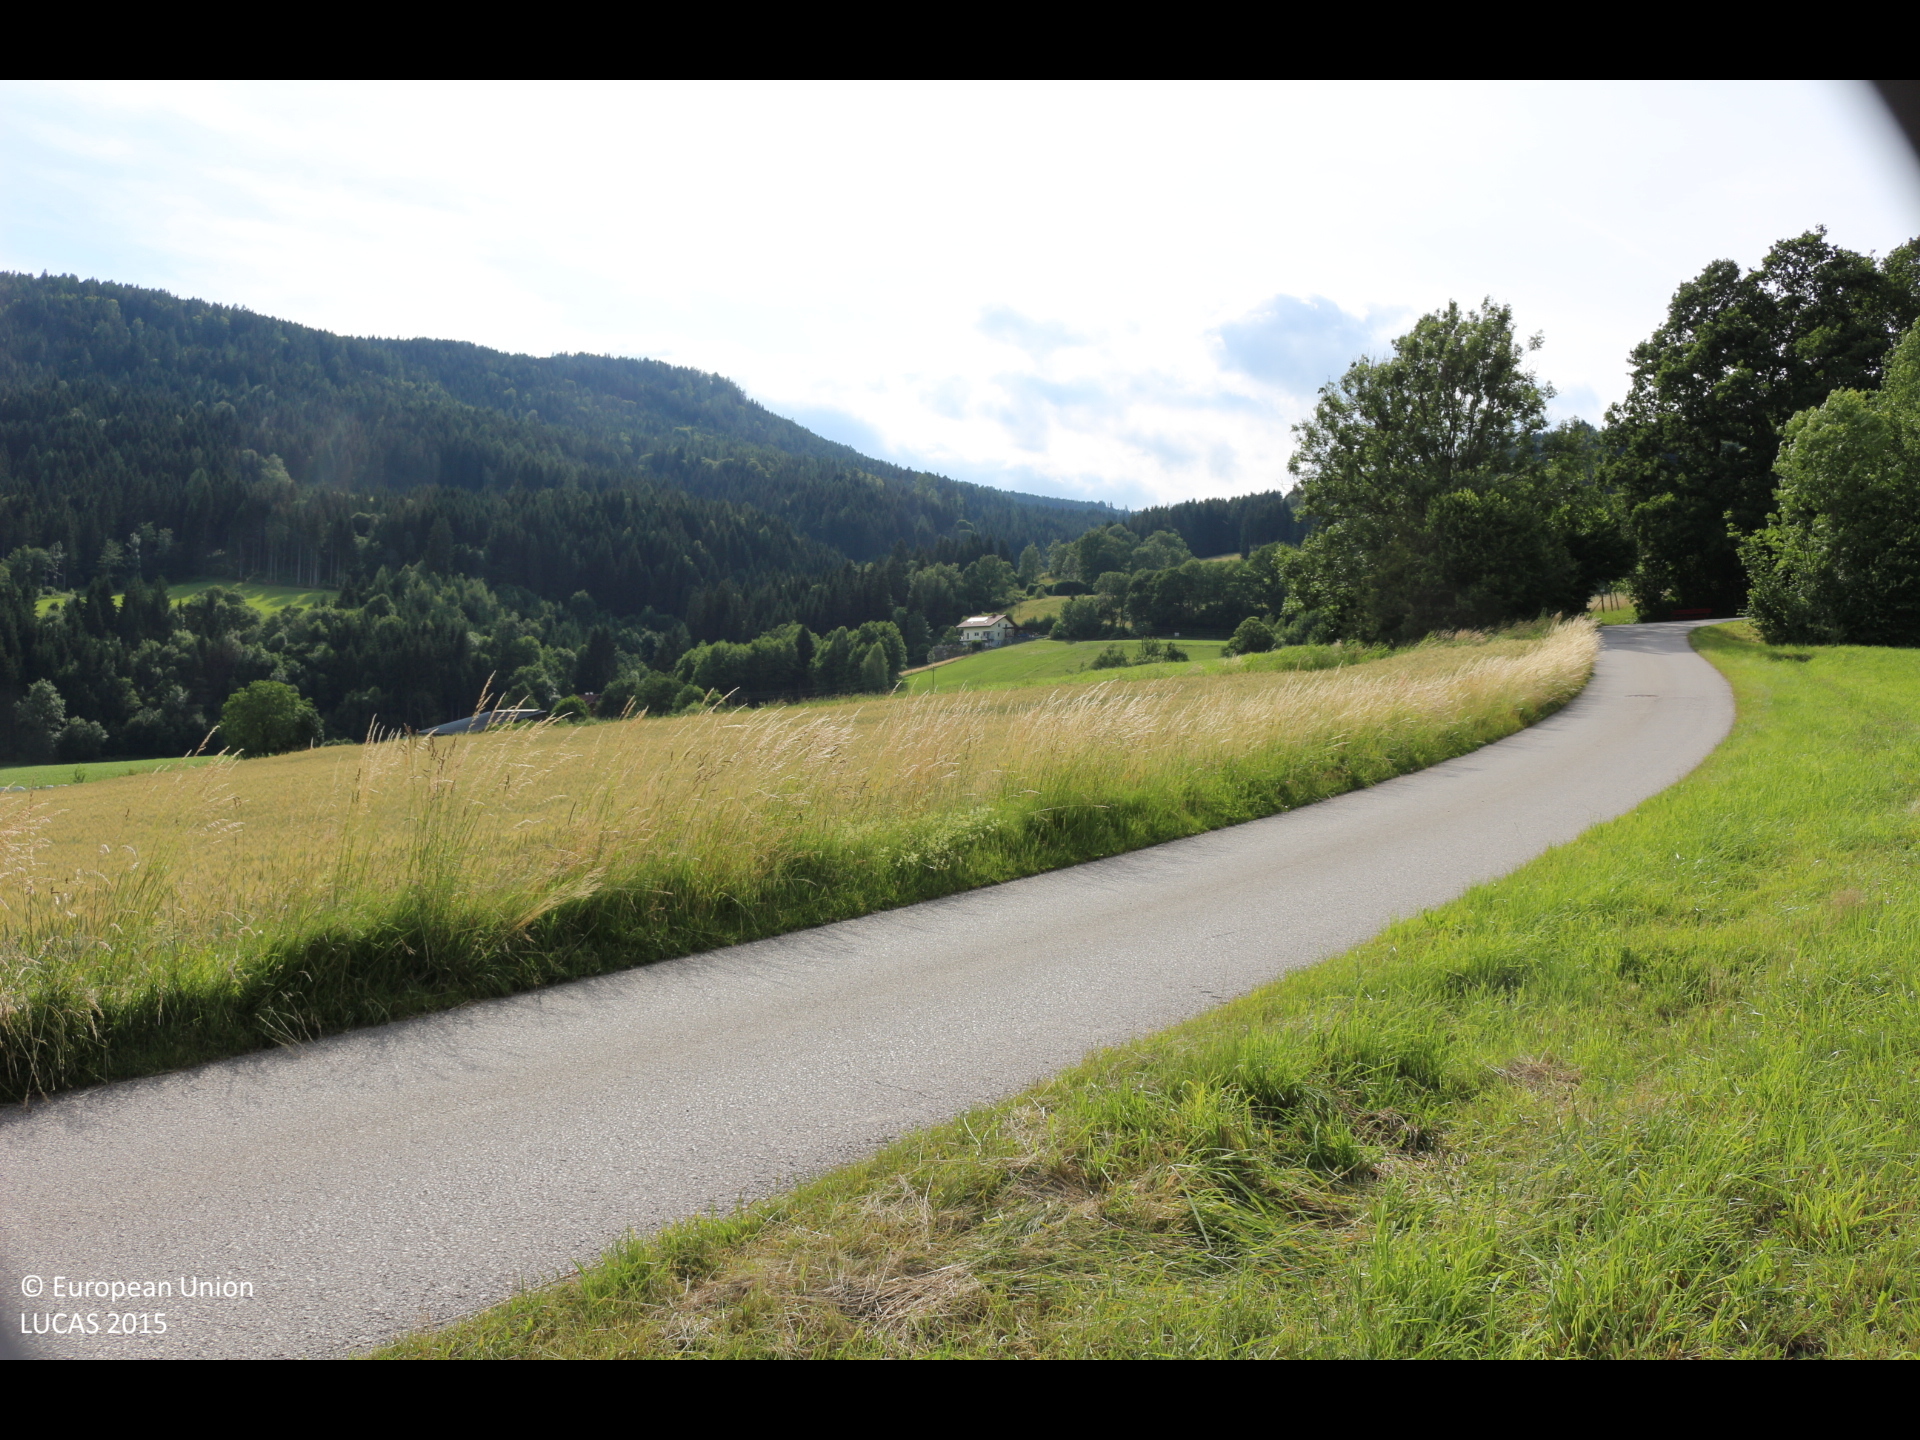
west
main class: Grassland
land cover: Grassland without tree/shrub cover
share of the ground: > 75 %
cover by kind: herbaceous plants 100 %
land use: Agriculture (excluding fallow land and kitchen gardens)
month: June
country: AT
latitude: 46.7257
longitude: 14.0406
